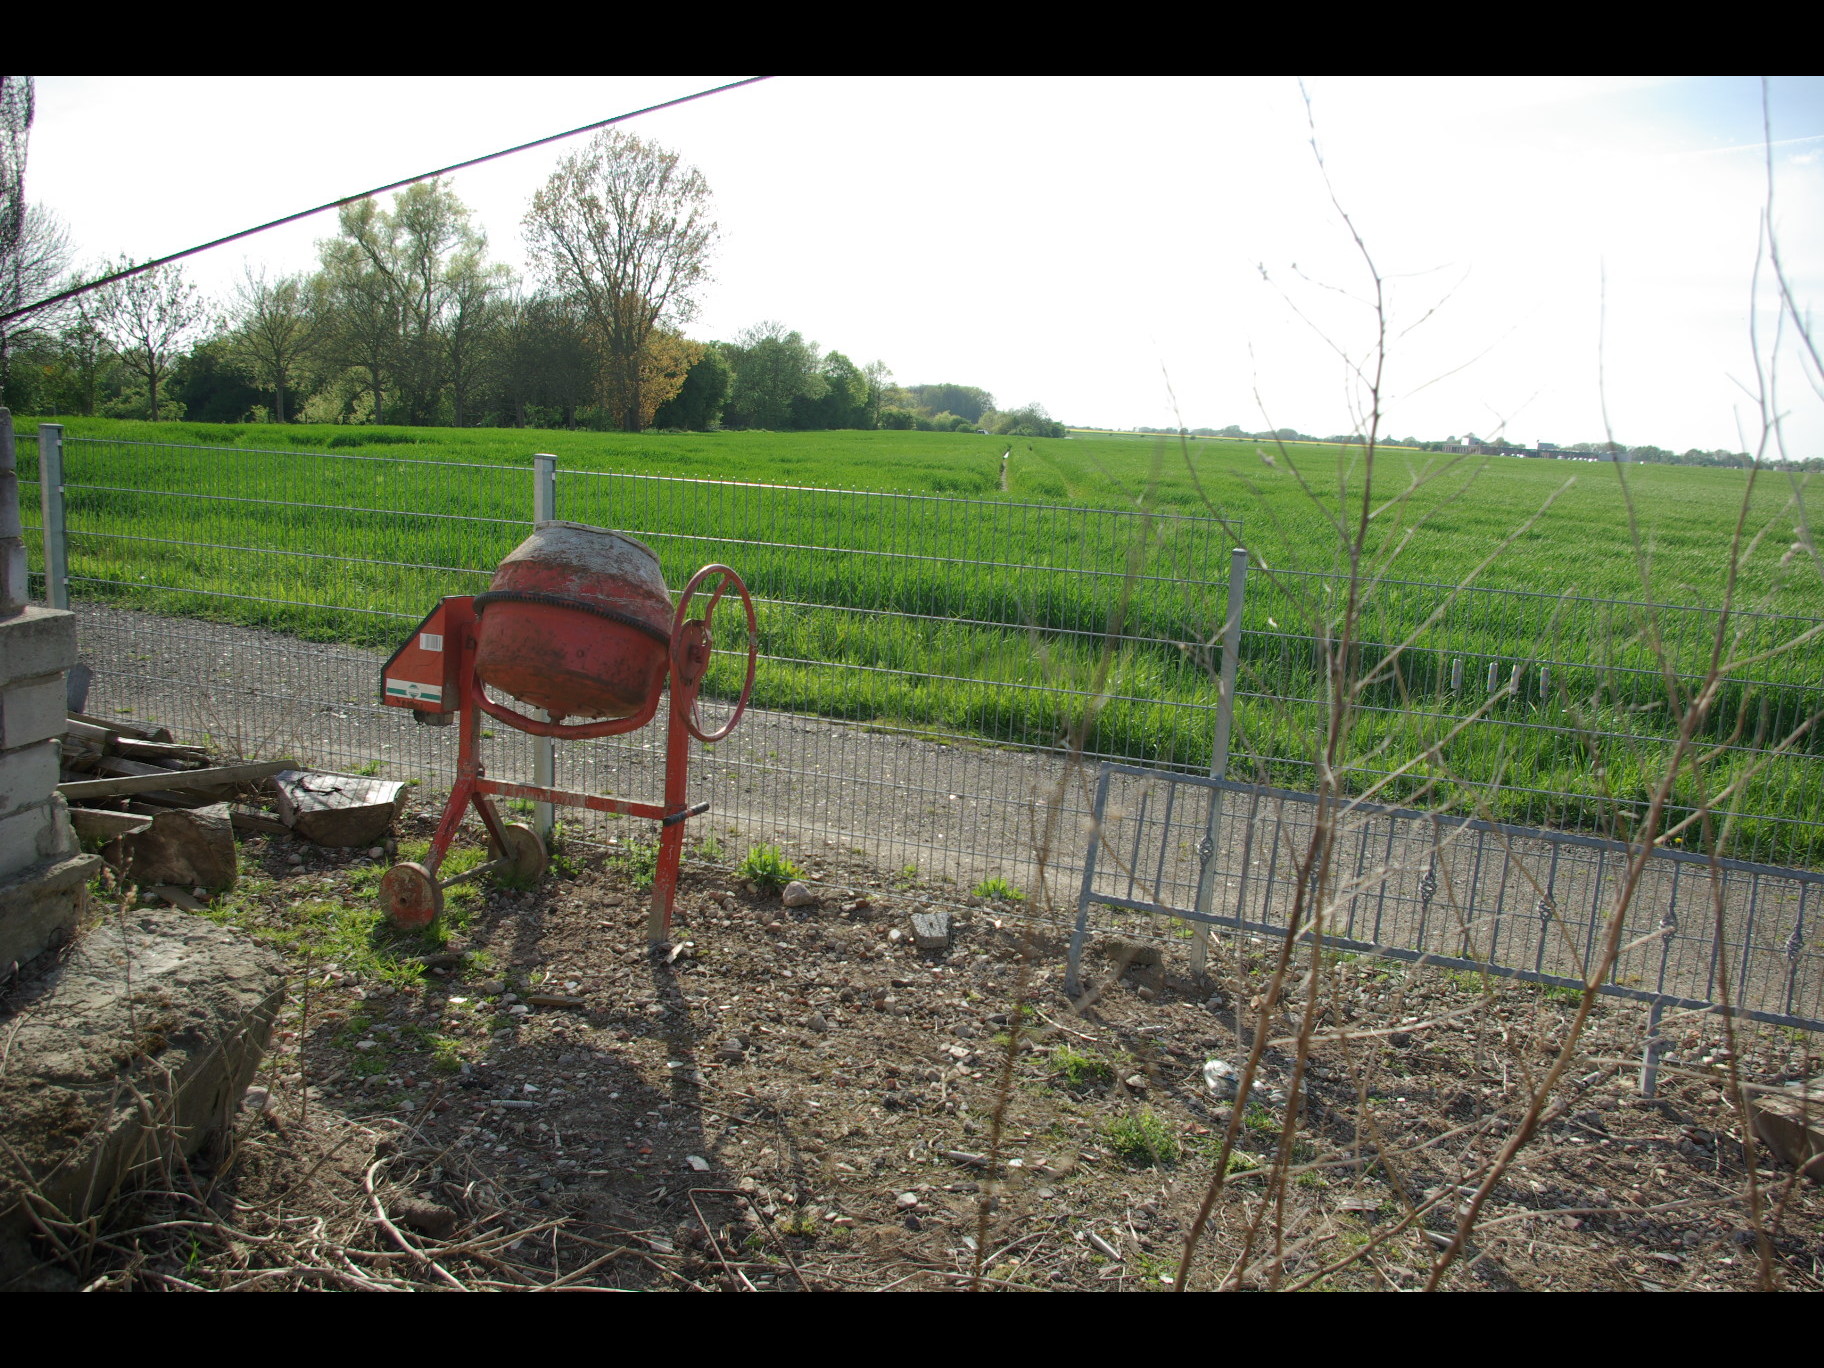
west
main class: Grassland
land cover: Spontaneously vegetated surfaces
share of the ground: > 75 %
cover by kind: herbaceous plants 100 %
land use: Residential
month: May
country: DE
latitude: 54.4386
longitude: 11.1865
